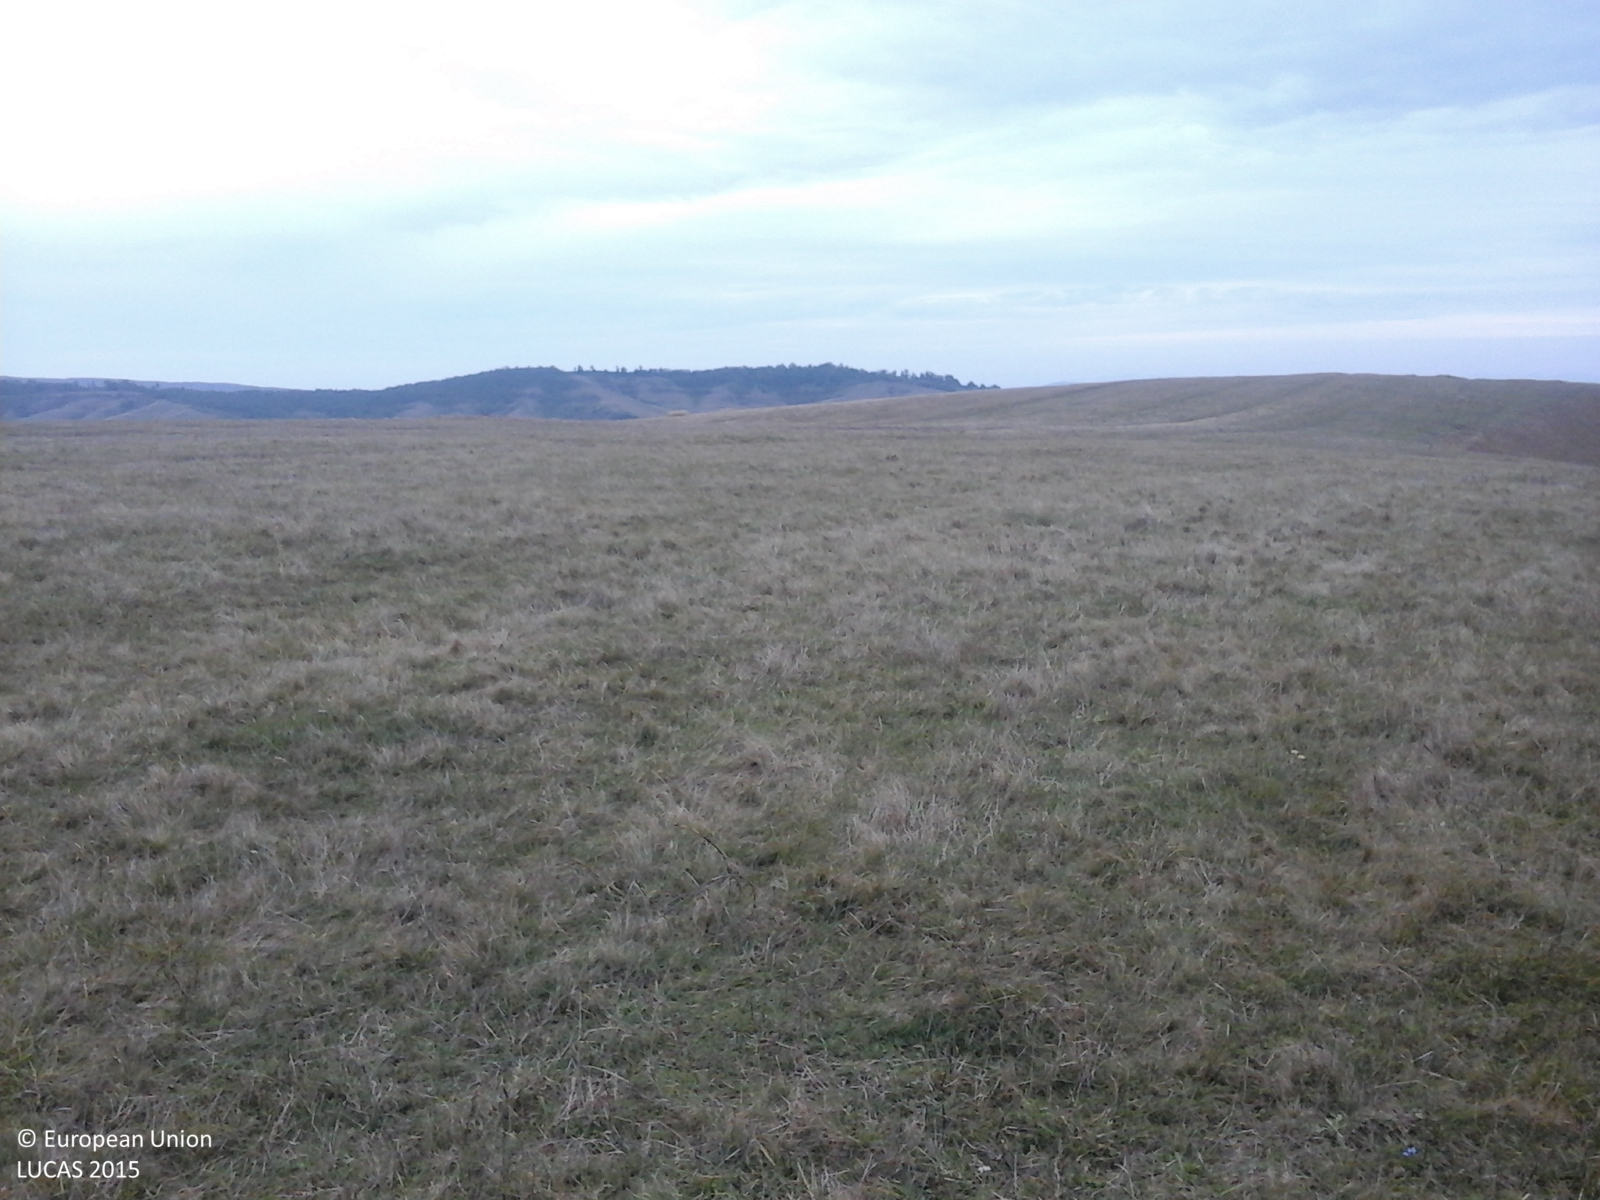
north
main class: Grassland
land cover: Grassland without tree/shrub cover
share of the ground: > 75 %
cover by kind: herbaceous plants 100 %
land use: Agriculture (excluding fallow land and kitchen gardens)
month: October
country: RO
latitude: 46.0377
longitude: 24.9920
